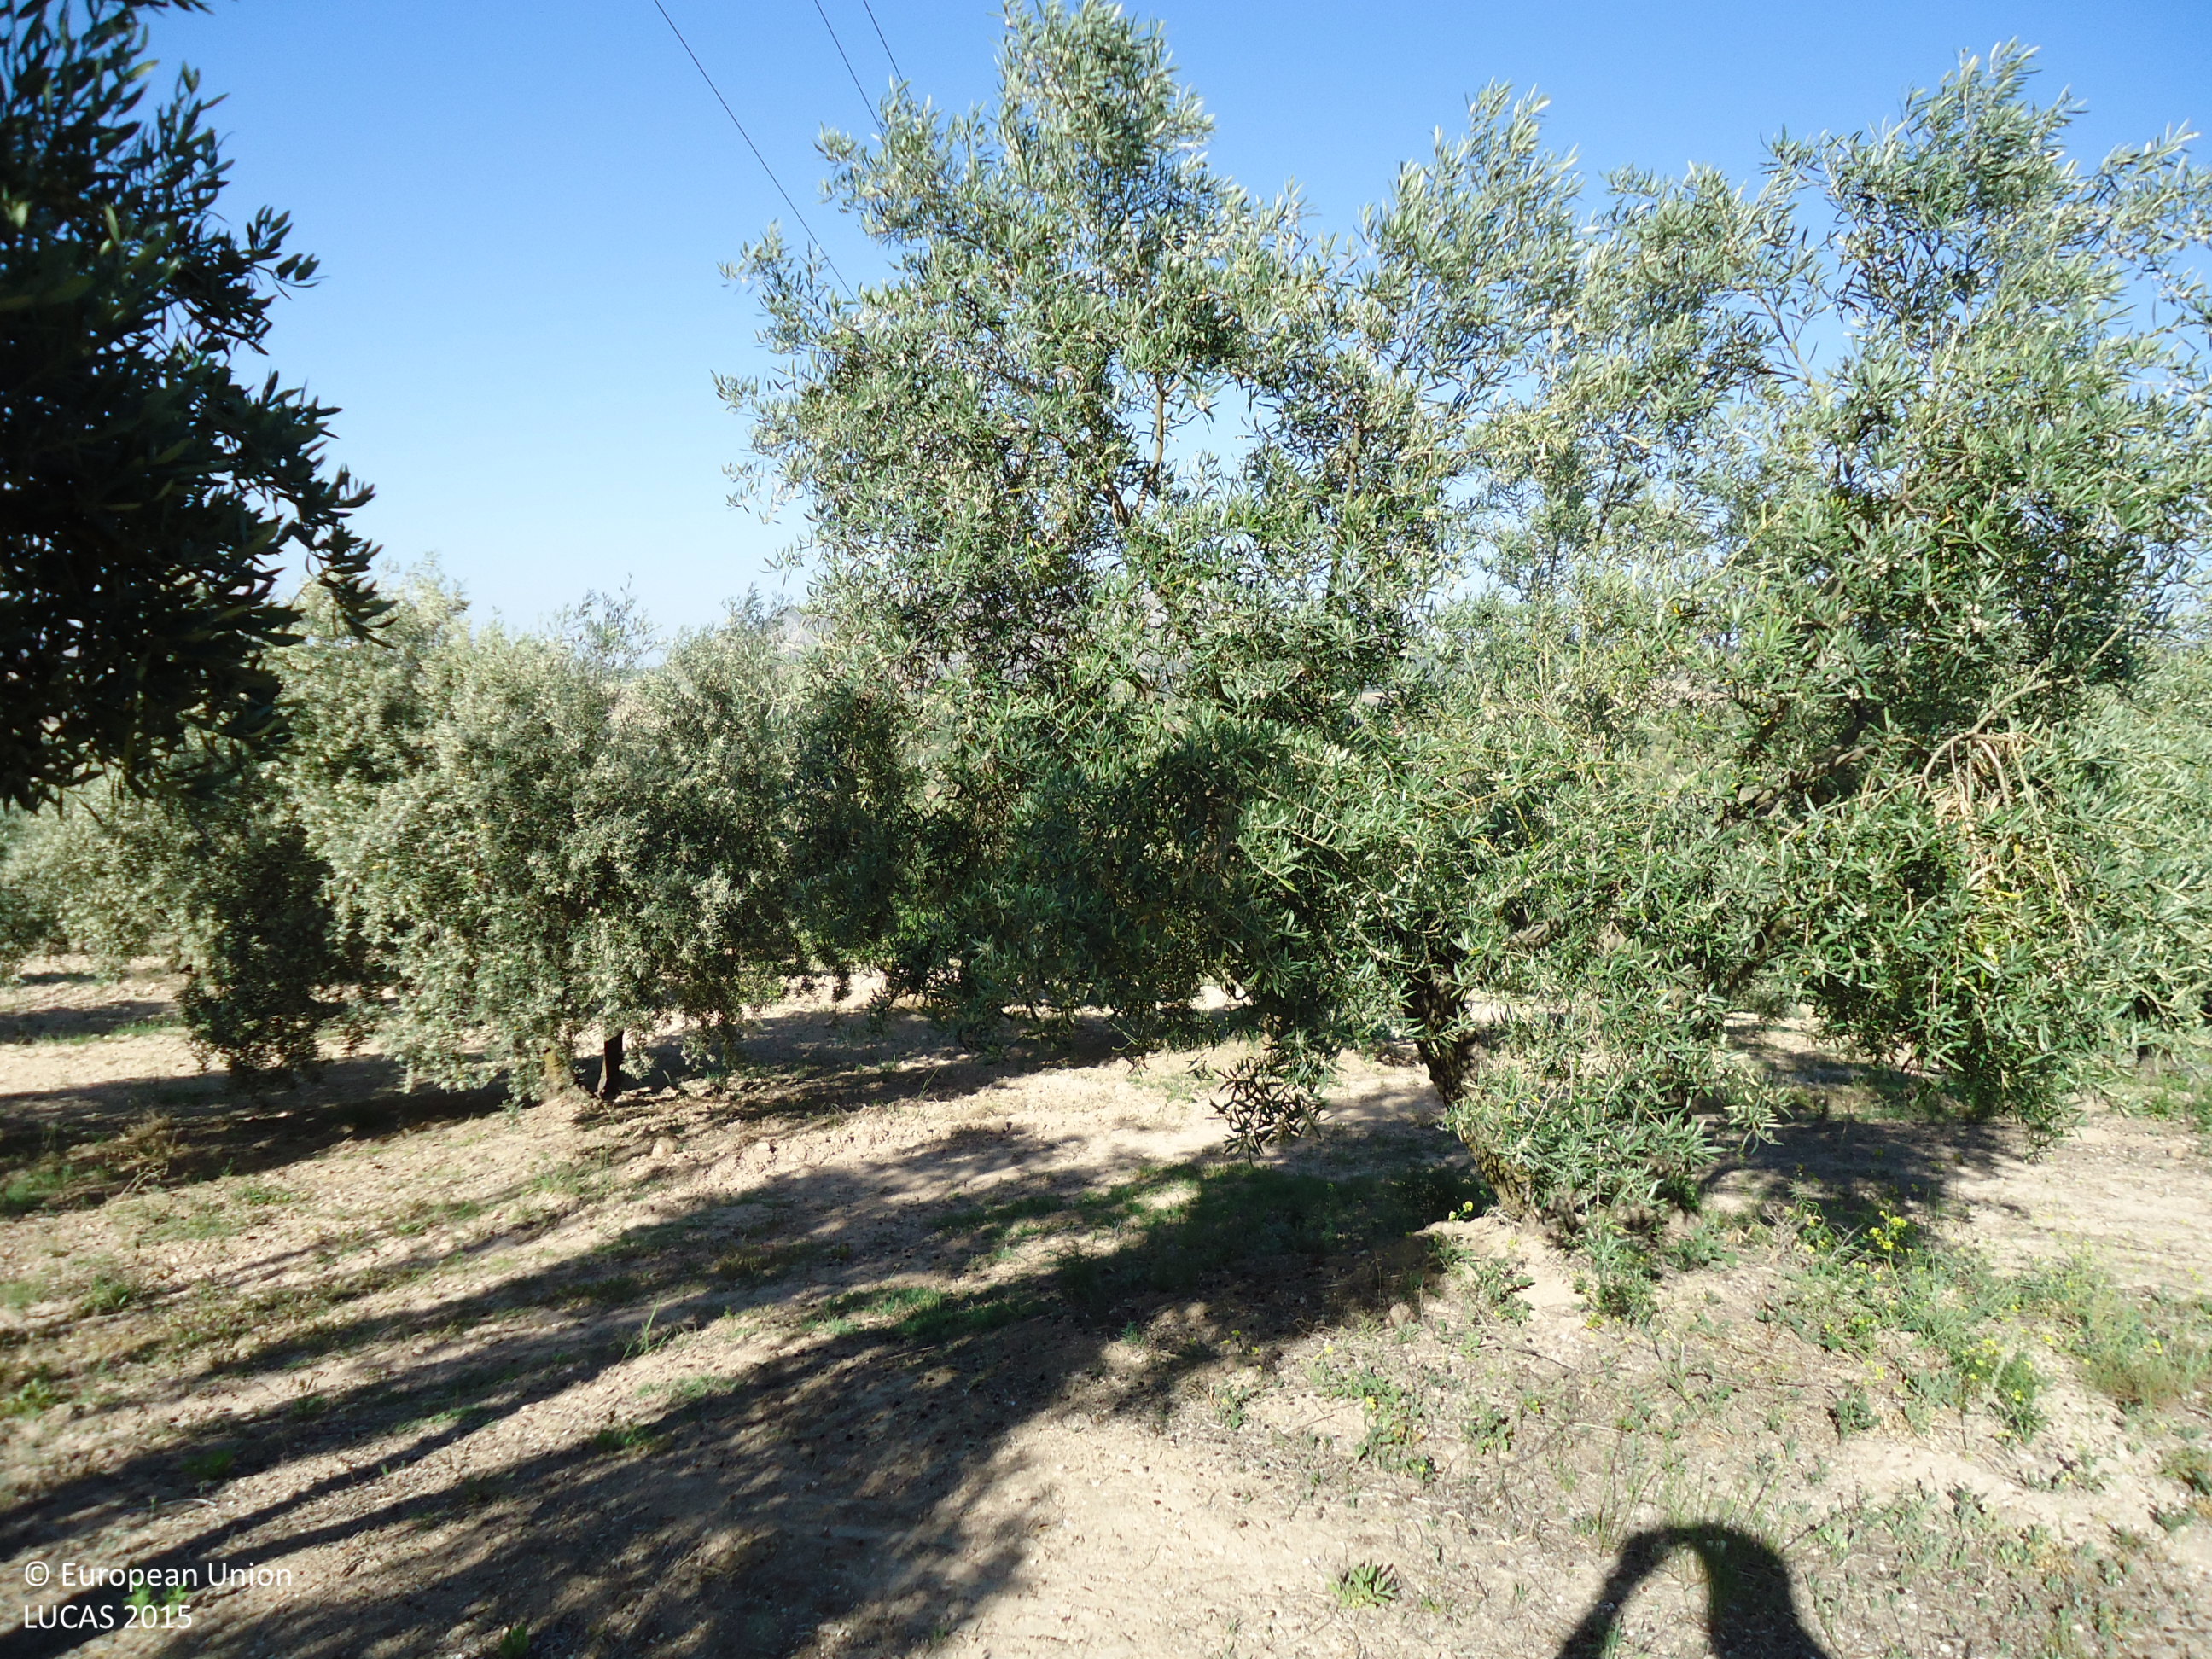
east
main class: Cropland
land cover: Olive groves
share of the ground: > 75 %
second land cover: Spontaneously vegetated surfaces
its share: 50 - 75 %
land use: Agriculture (excluding fallow land and kitchen gardens)
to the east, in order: Olive groves; Spontaneously vegetated surfaces; Electric lines; Olive groves; Grass margins; Other non-permanent industrial crops; Grass margins; Olive groves
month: May
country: ES
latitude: 36.8817
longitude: -5.0004
